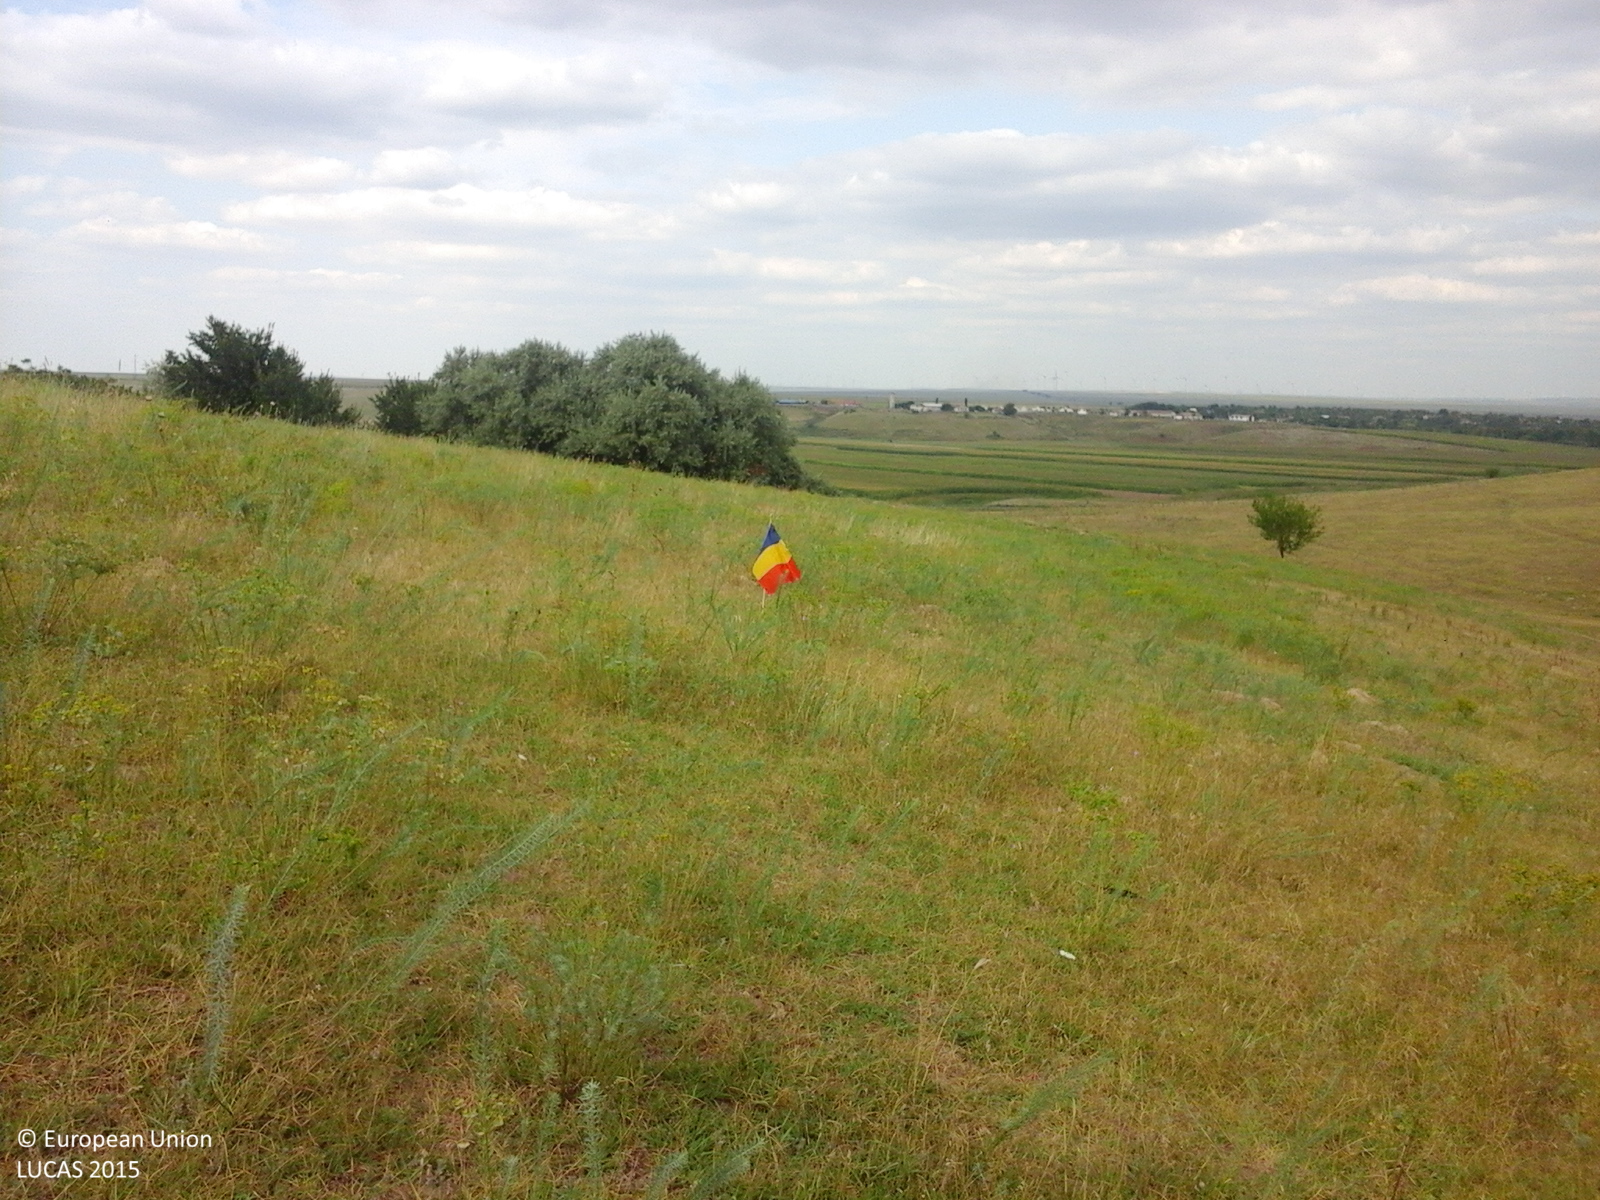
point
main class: Grassland
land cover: Grassland without tree/shrub cover
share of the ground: > 75 %
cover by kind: herbaceous plants 100 %
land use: Agriculture (excluding fallow land and kitchen gardens)
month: August
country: RO
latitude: 44.7118
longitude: 28.1264
